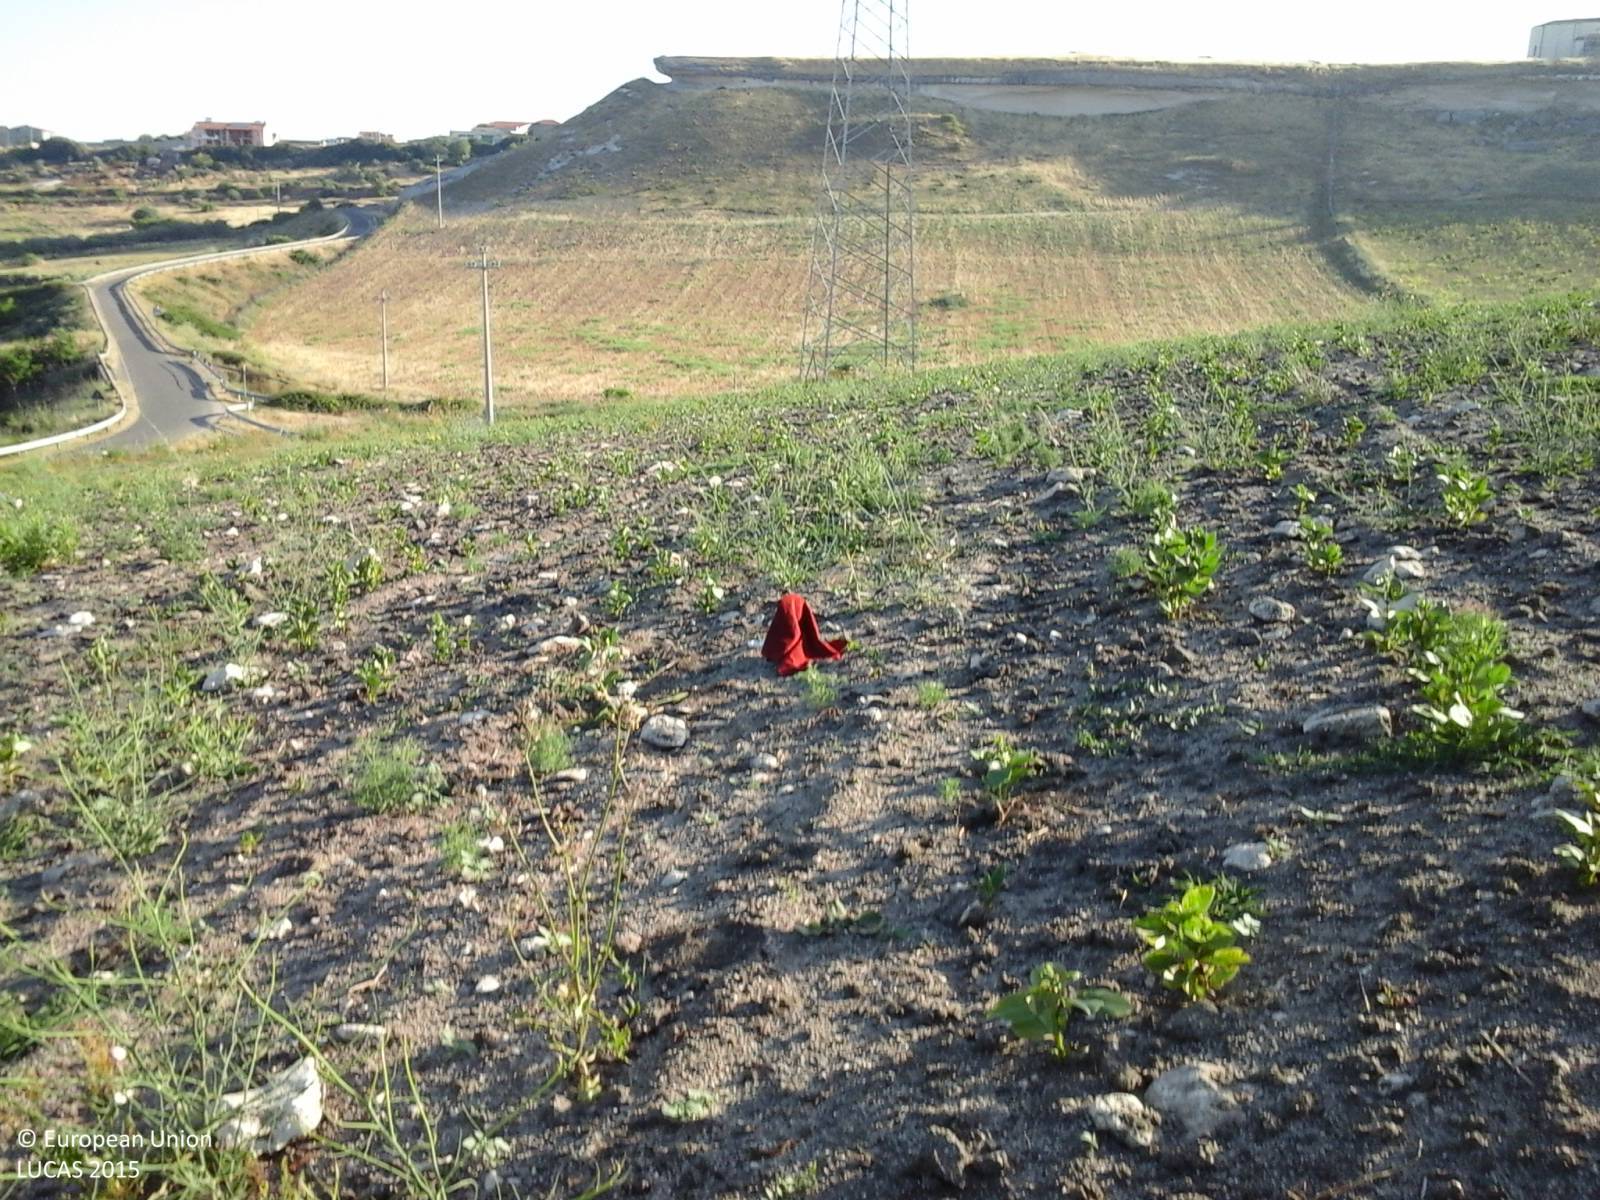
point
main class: Cropland
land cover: Dry pulses
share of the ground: < 10 %
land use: Agriculture (excluding fallow land and kitchen gardens)
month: June
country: IT
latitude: 40.6575
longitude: 8.7406
